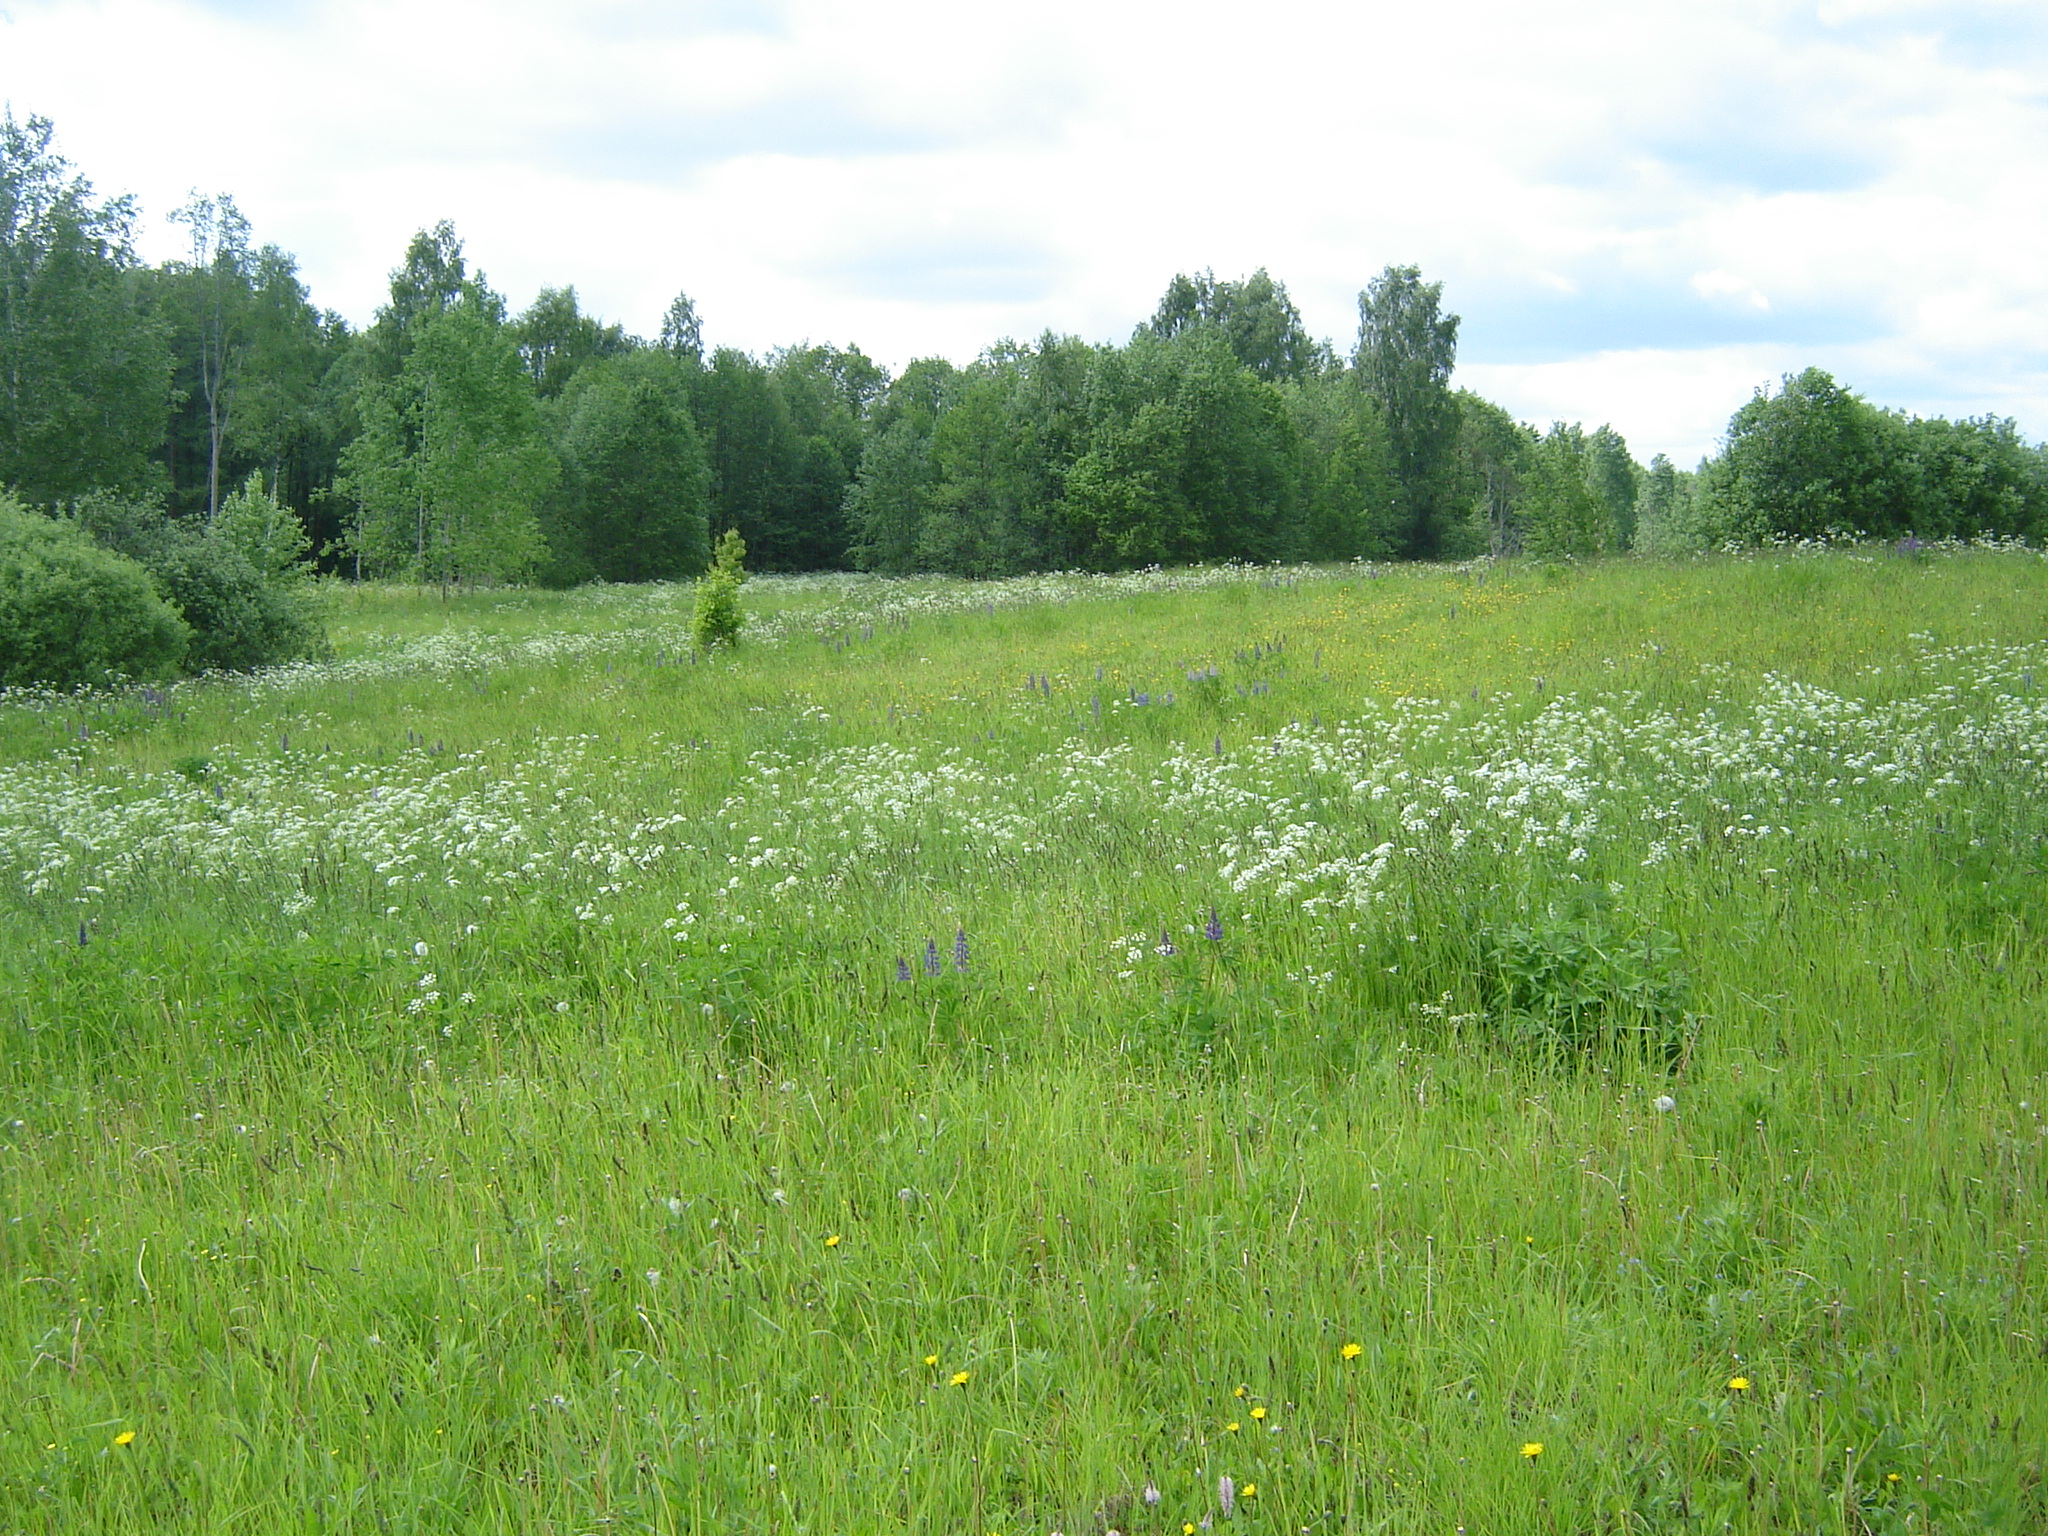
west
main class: Grassland
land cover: Grassland without tree/shrub cover
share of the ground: > 75 %
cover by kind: herbaceous plants 100 %
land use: Agriculture (excluding fallow land and kitchen gardens)
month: June
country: LT
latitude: 55.7049
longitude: 25.5777
